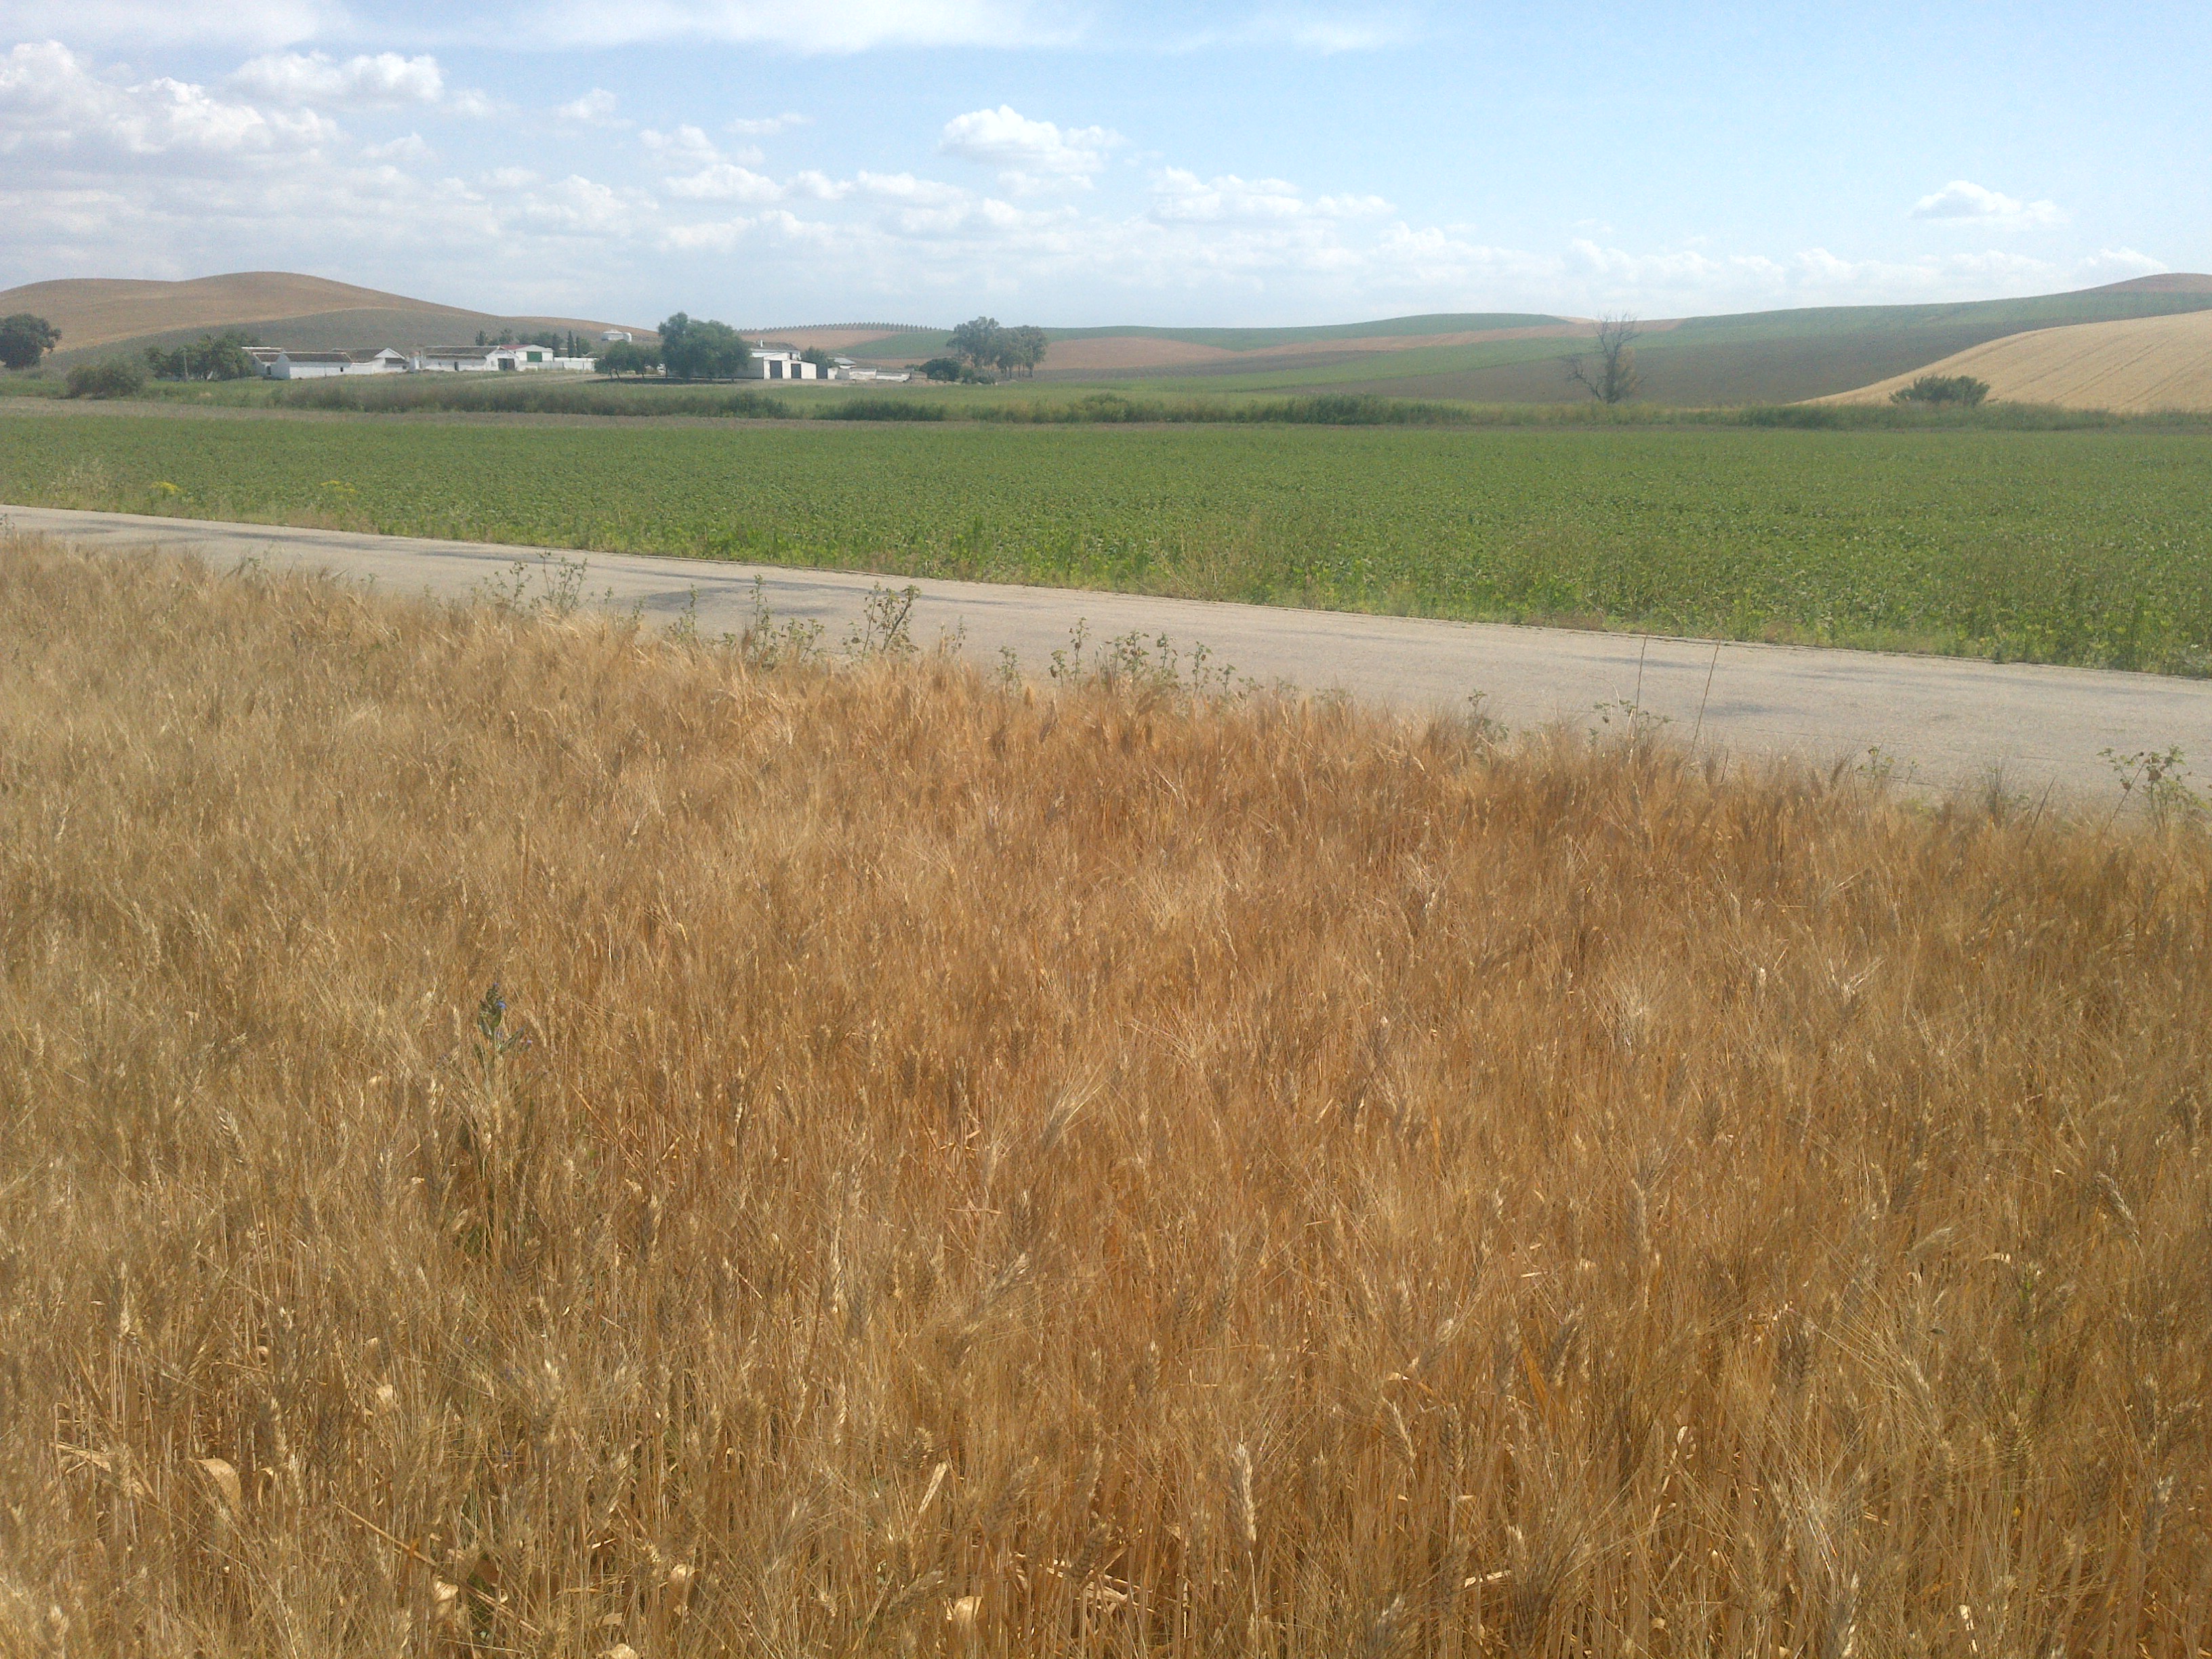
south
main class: Cropland
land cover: Durum wheat
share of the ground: > 75 %
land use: Agriculture (excluding fallow land and kitchen gardens)
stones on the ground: 10 - 25 %
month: May
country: ES
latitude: 37.8502
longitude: -4.4543
